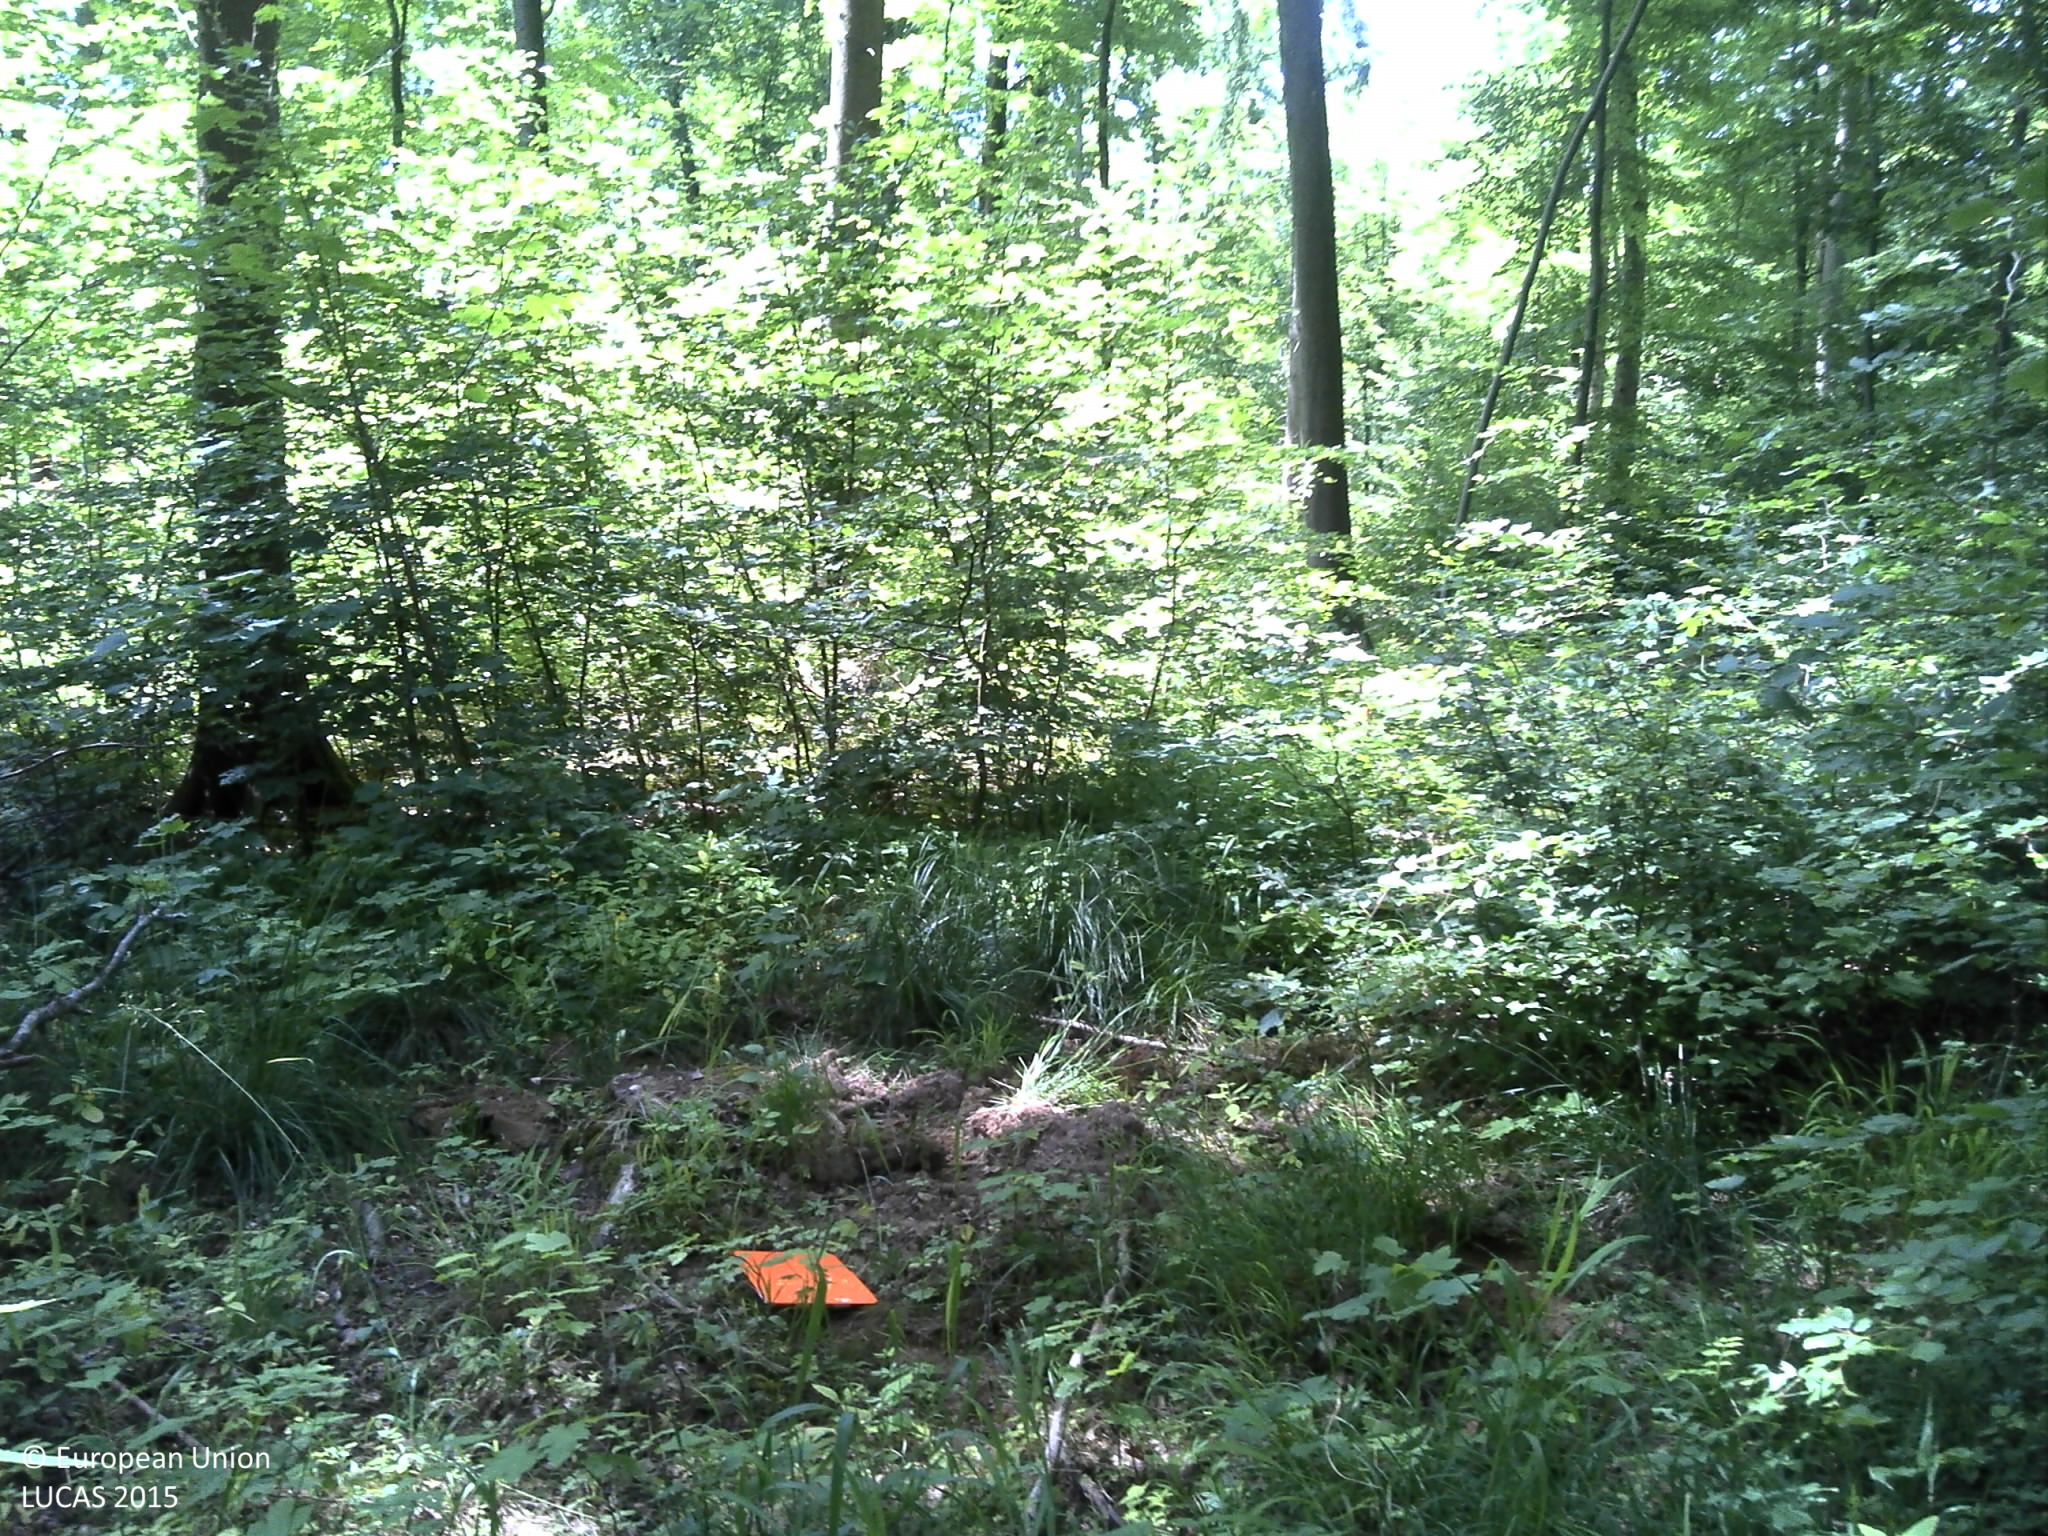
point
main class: Woodland
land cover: Broadleaved woodland
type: beech forest
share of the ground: > 75 %
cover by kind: broadleaved forest trees 80 %, coniferous forest trees 10 %, herbaceous plants 10 %
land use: Forestry
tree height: > 5 m
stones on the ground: < 10 %
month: June
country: FR
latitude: 49.2877
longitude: 6.0537
